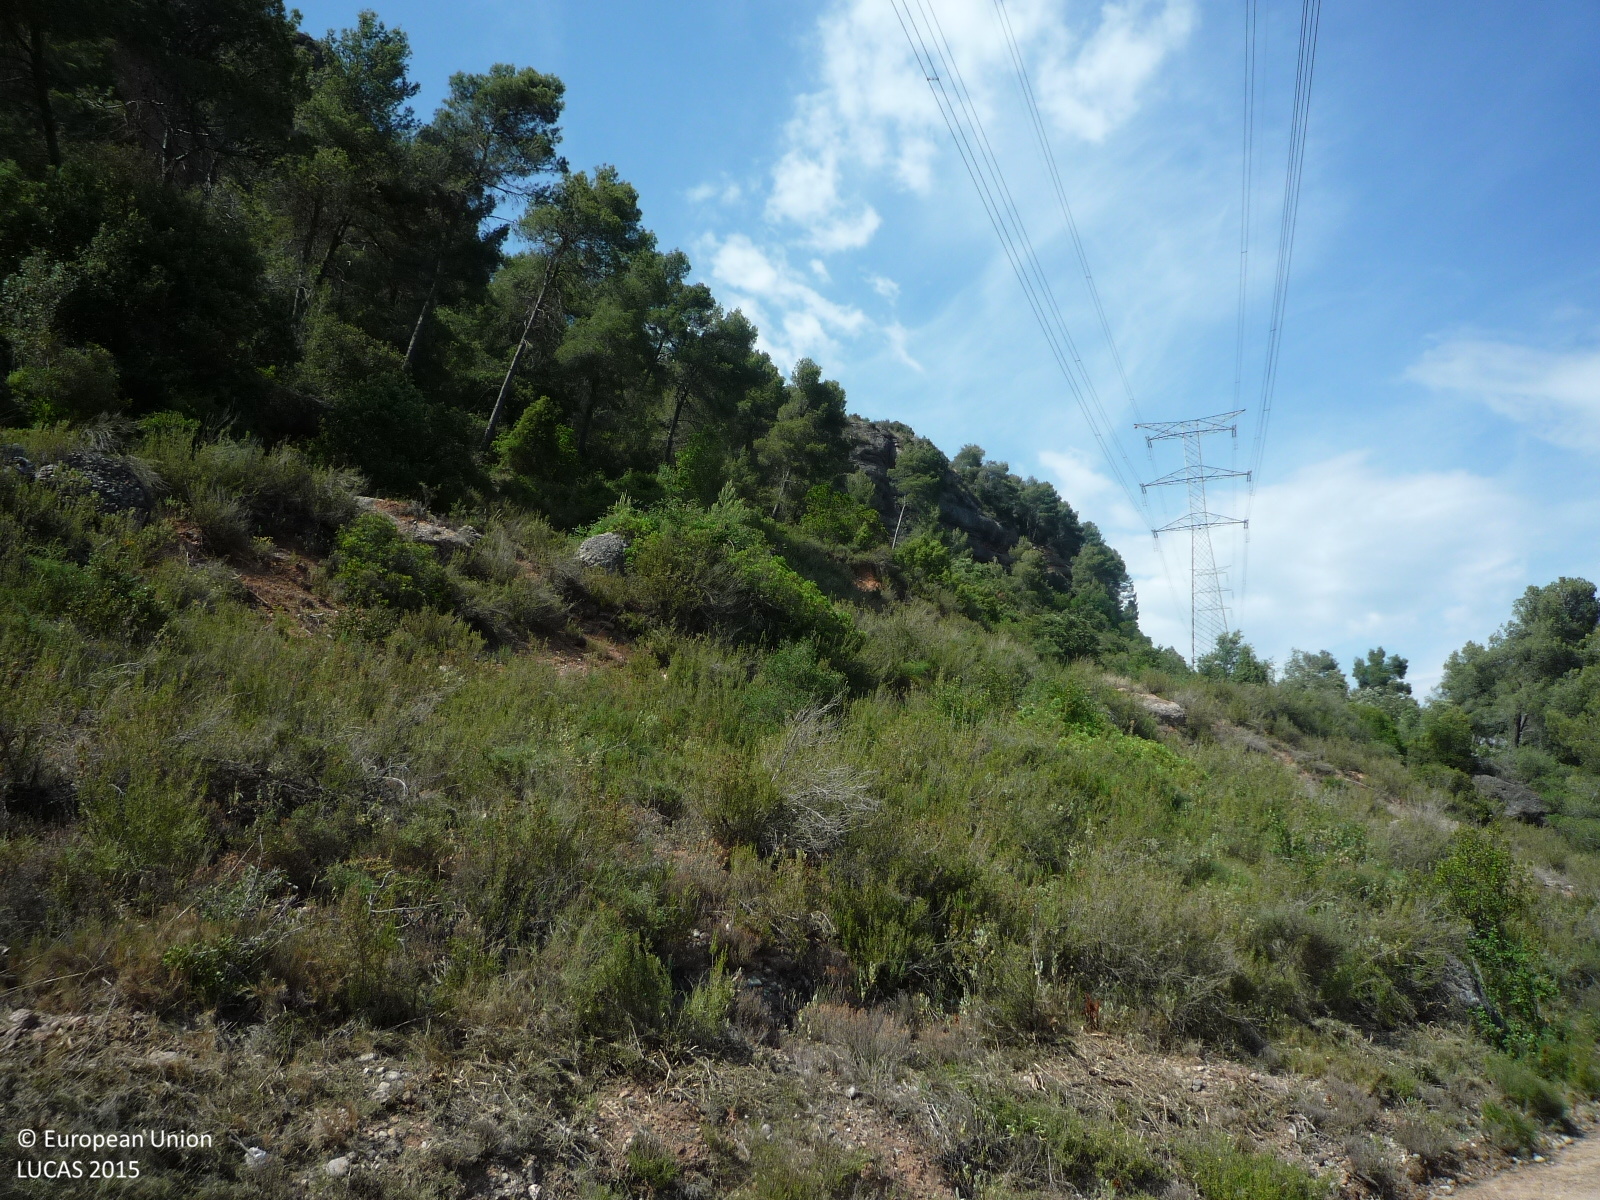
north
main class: Woodland
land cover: Pine dominated mixed woodland
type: coniferous forest of the mediterranean region
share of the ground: > 75 %
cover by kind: coniferous forest trees 60 %, broadleaved forest trees 40 %
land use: Semi-natural and natural areas not in use
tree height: > 5 m
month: June
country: ES
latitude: 41.6624
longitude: 1.9575
